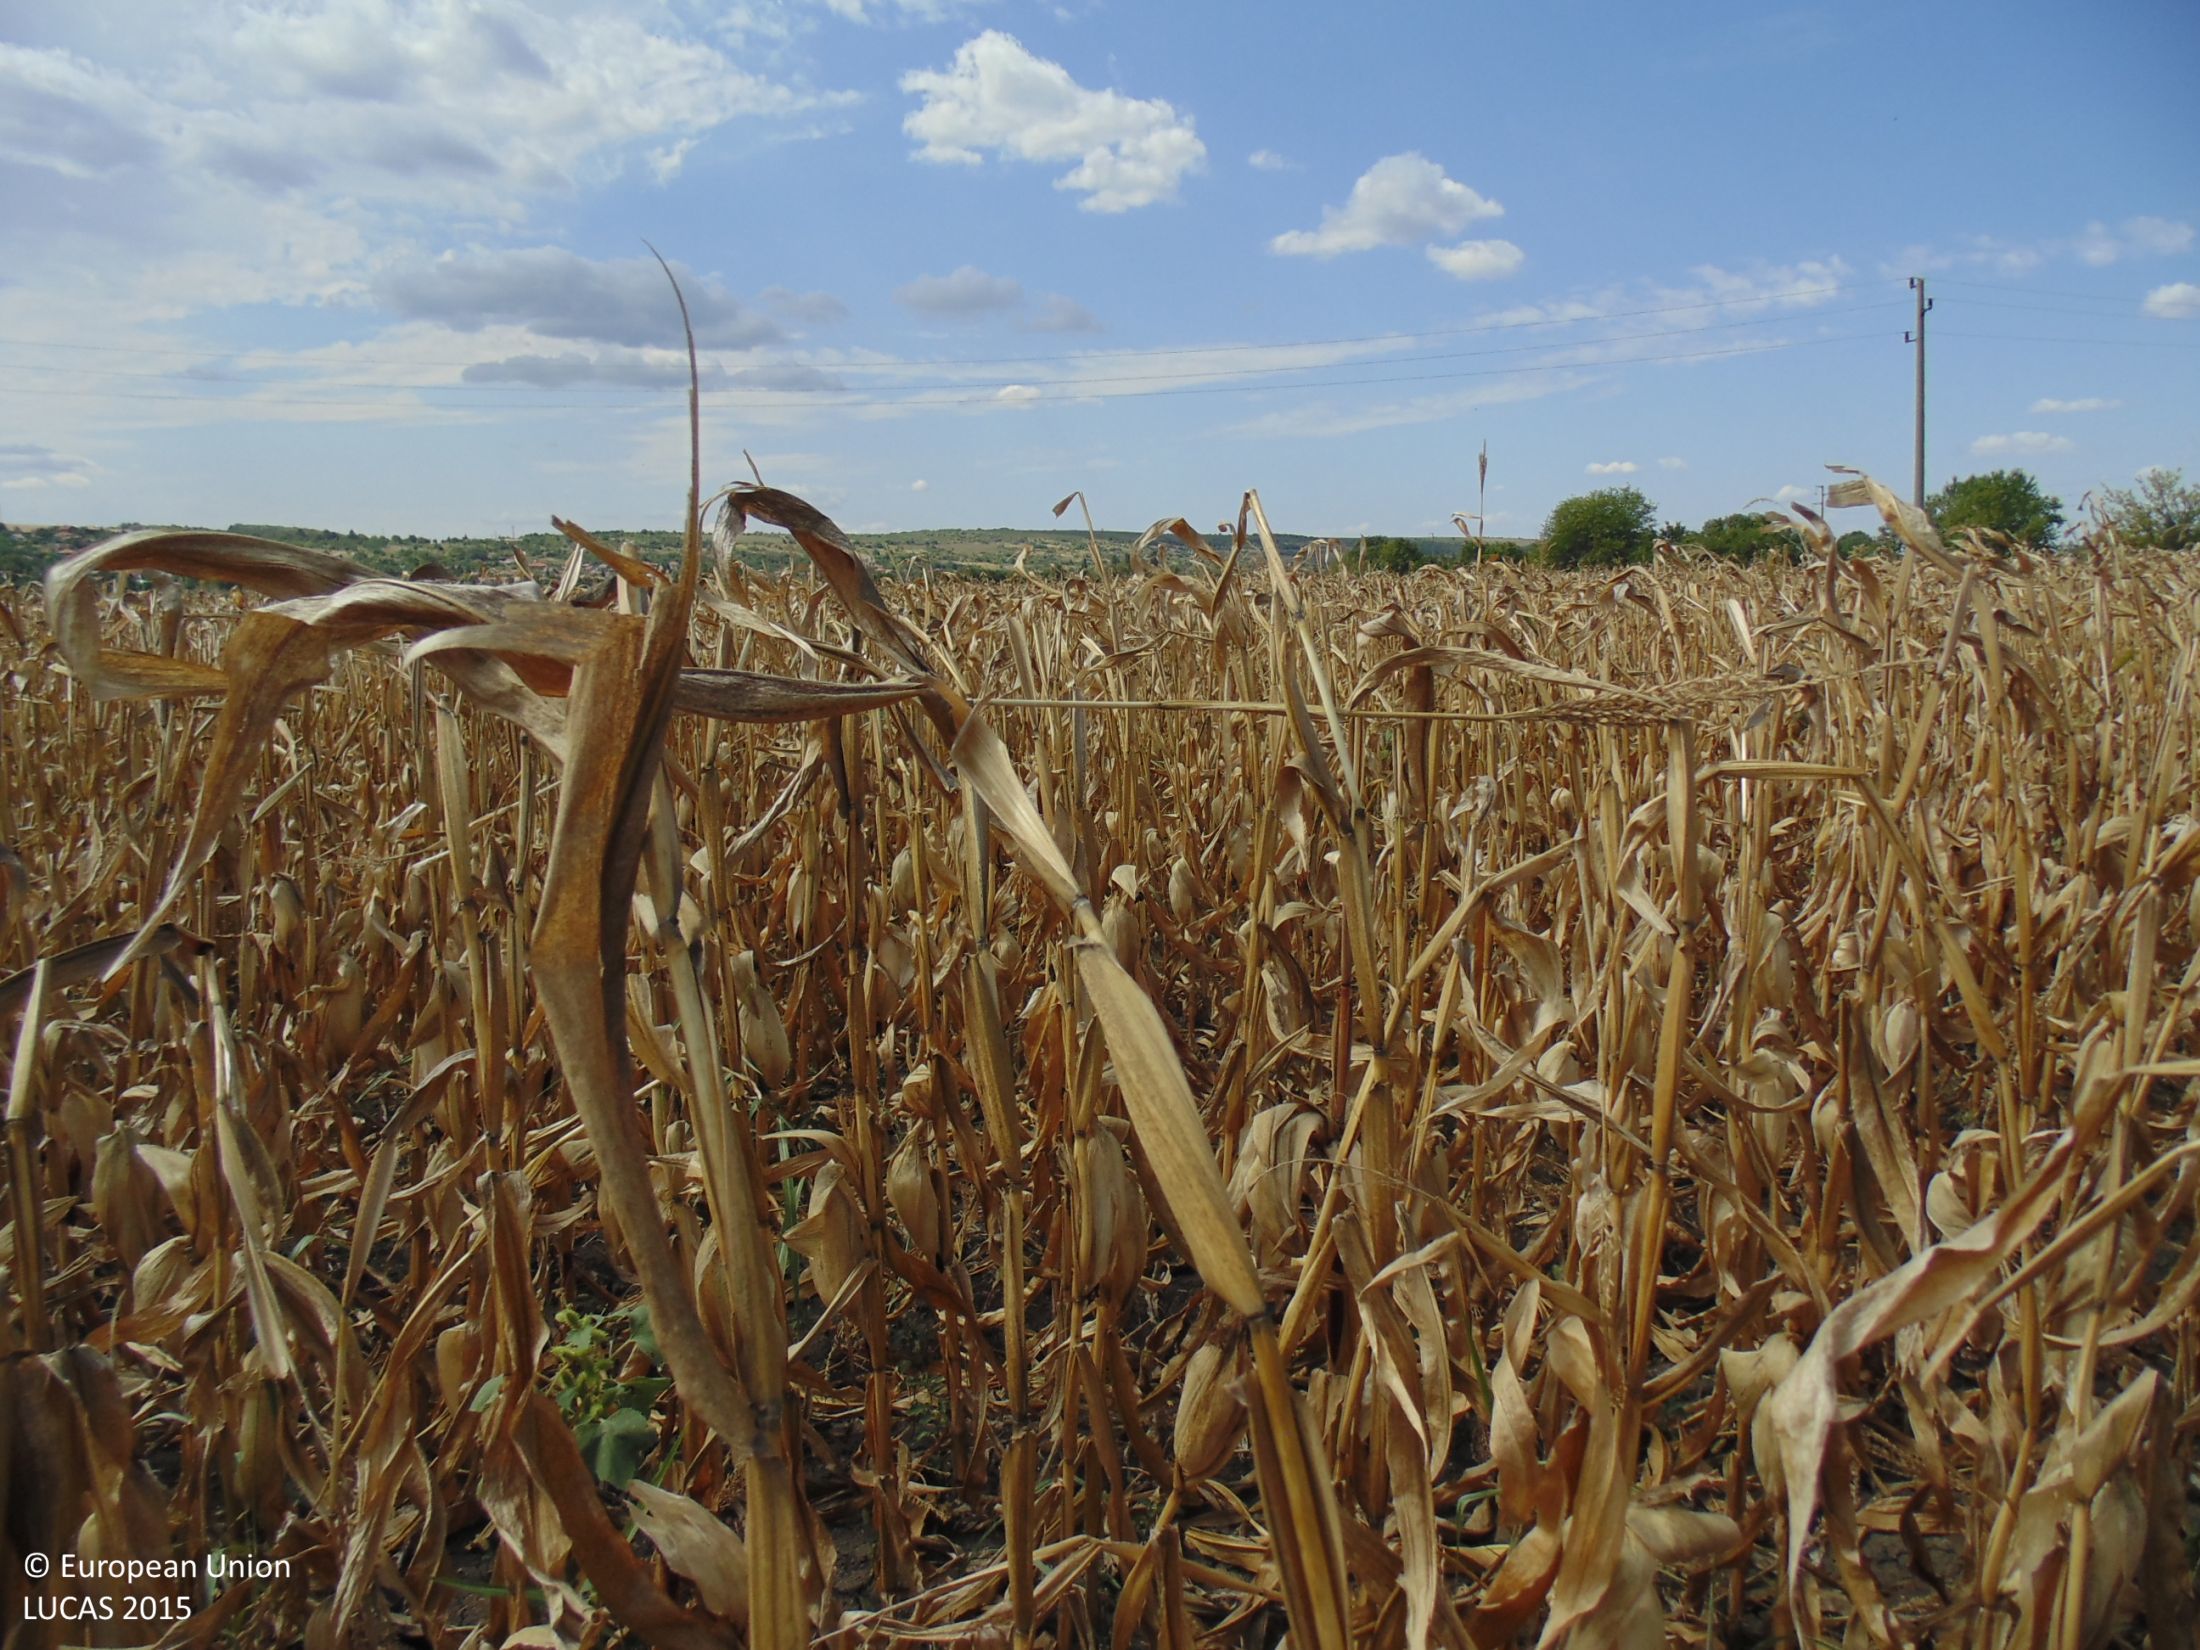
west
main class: Cropland
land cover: Maize
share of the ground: > 75 %
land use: Agriculture (excluding fallow land and kitchen gardens)
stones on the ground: < 10 %
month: September
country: BG
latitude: 44.1051
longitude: 27.1566
